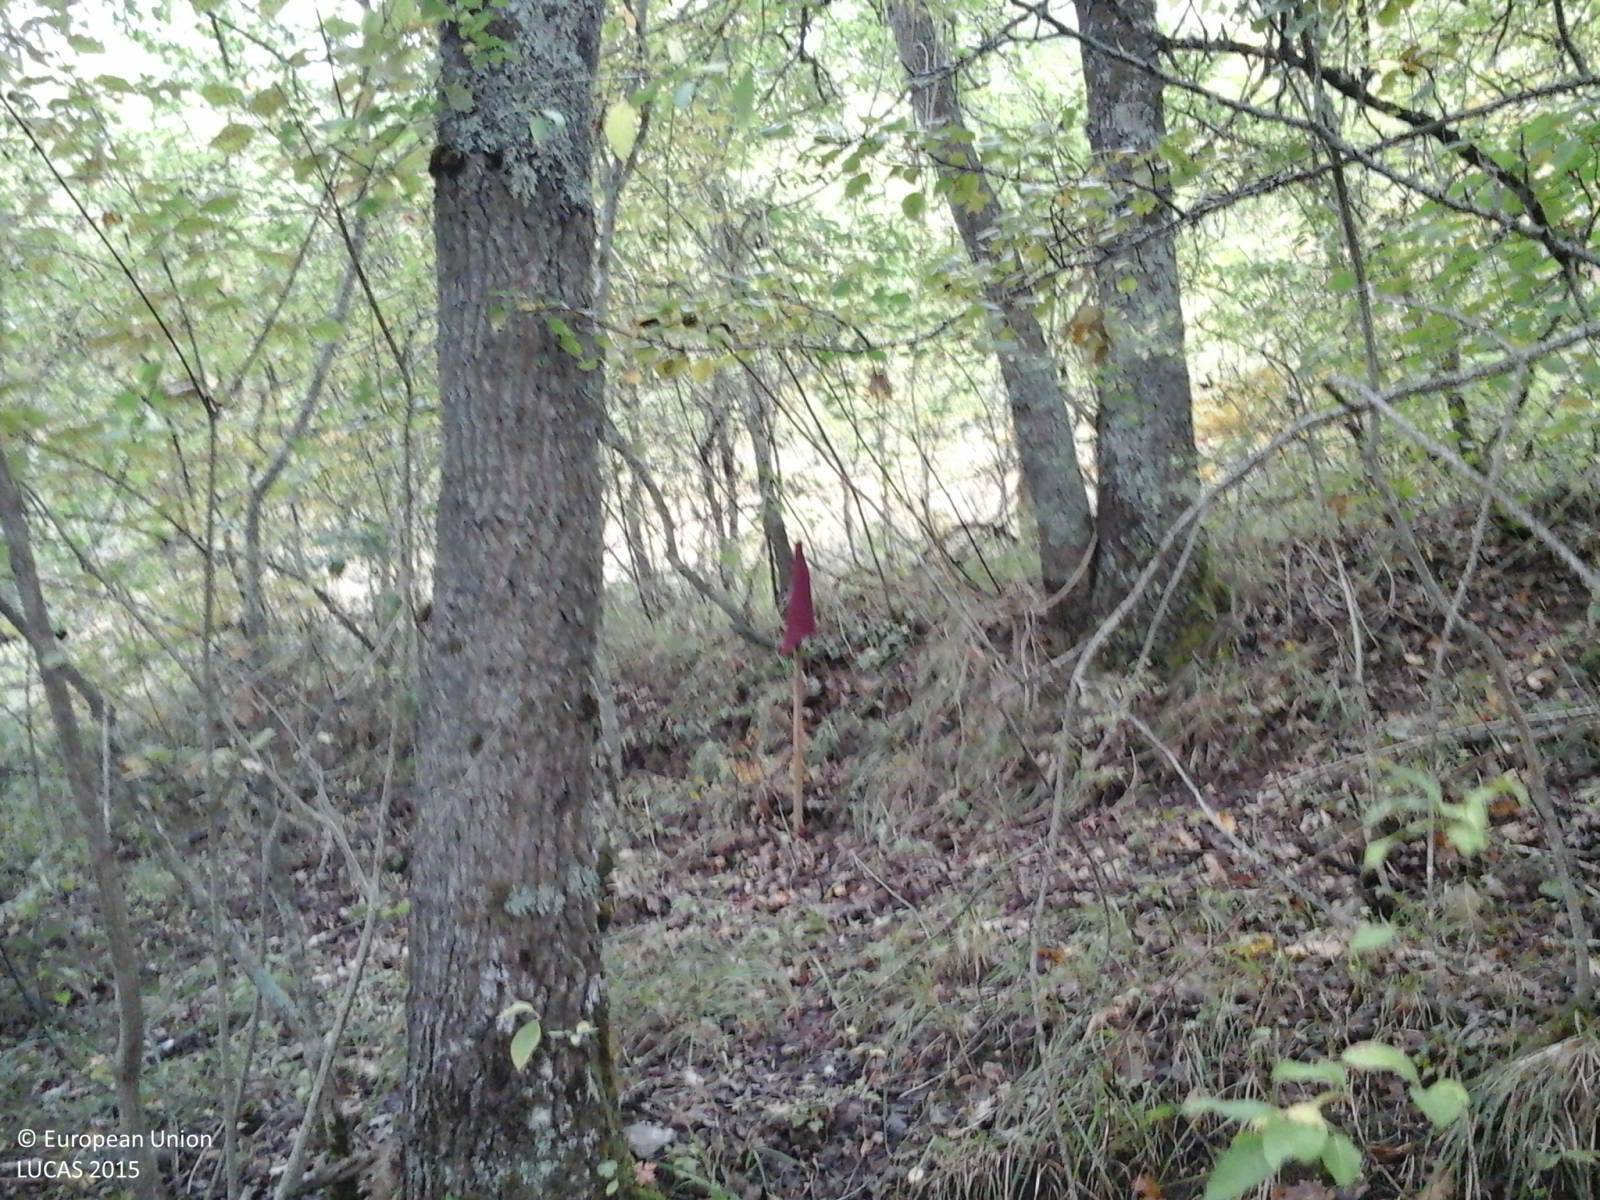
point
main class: Woodland
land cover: Broadleaved woodland
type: thermophilous deciduous forest
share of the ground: > 75 %
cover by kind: broadleaved forest trees 90 %, shrubs 10 %
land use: Forestry
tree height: > 5 m
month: October
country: IT
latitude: 42.6578
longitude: 13.1986
